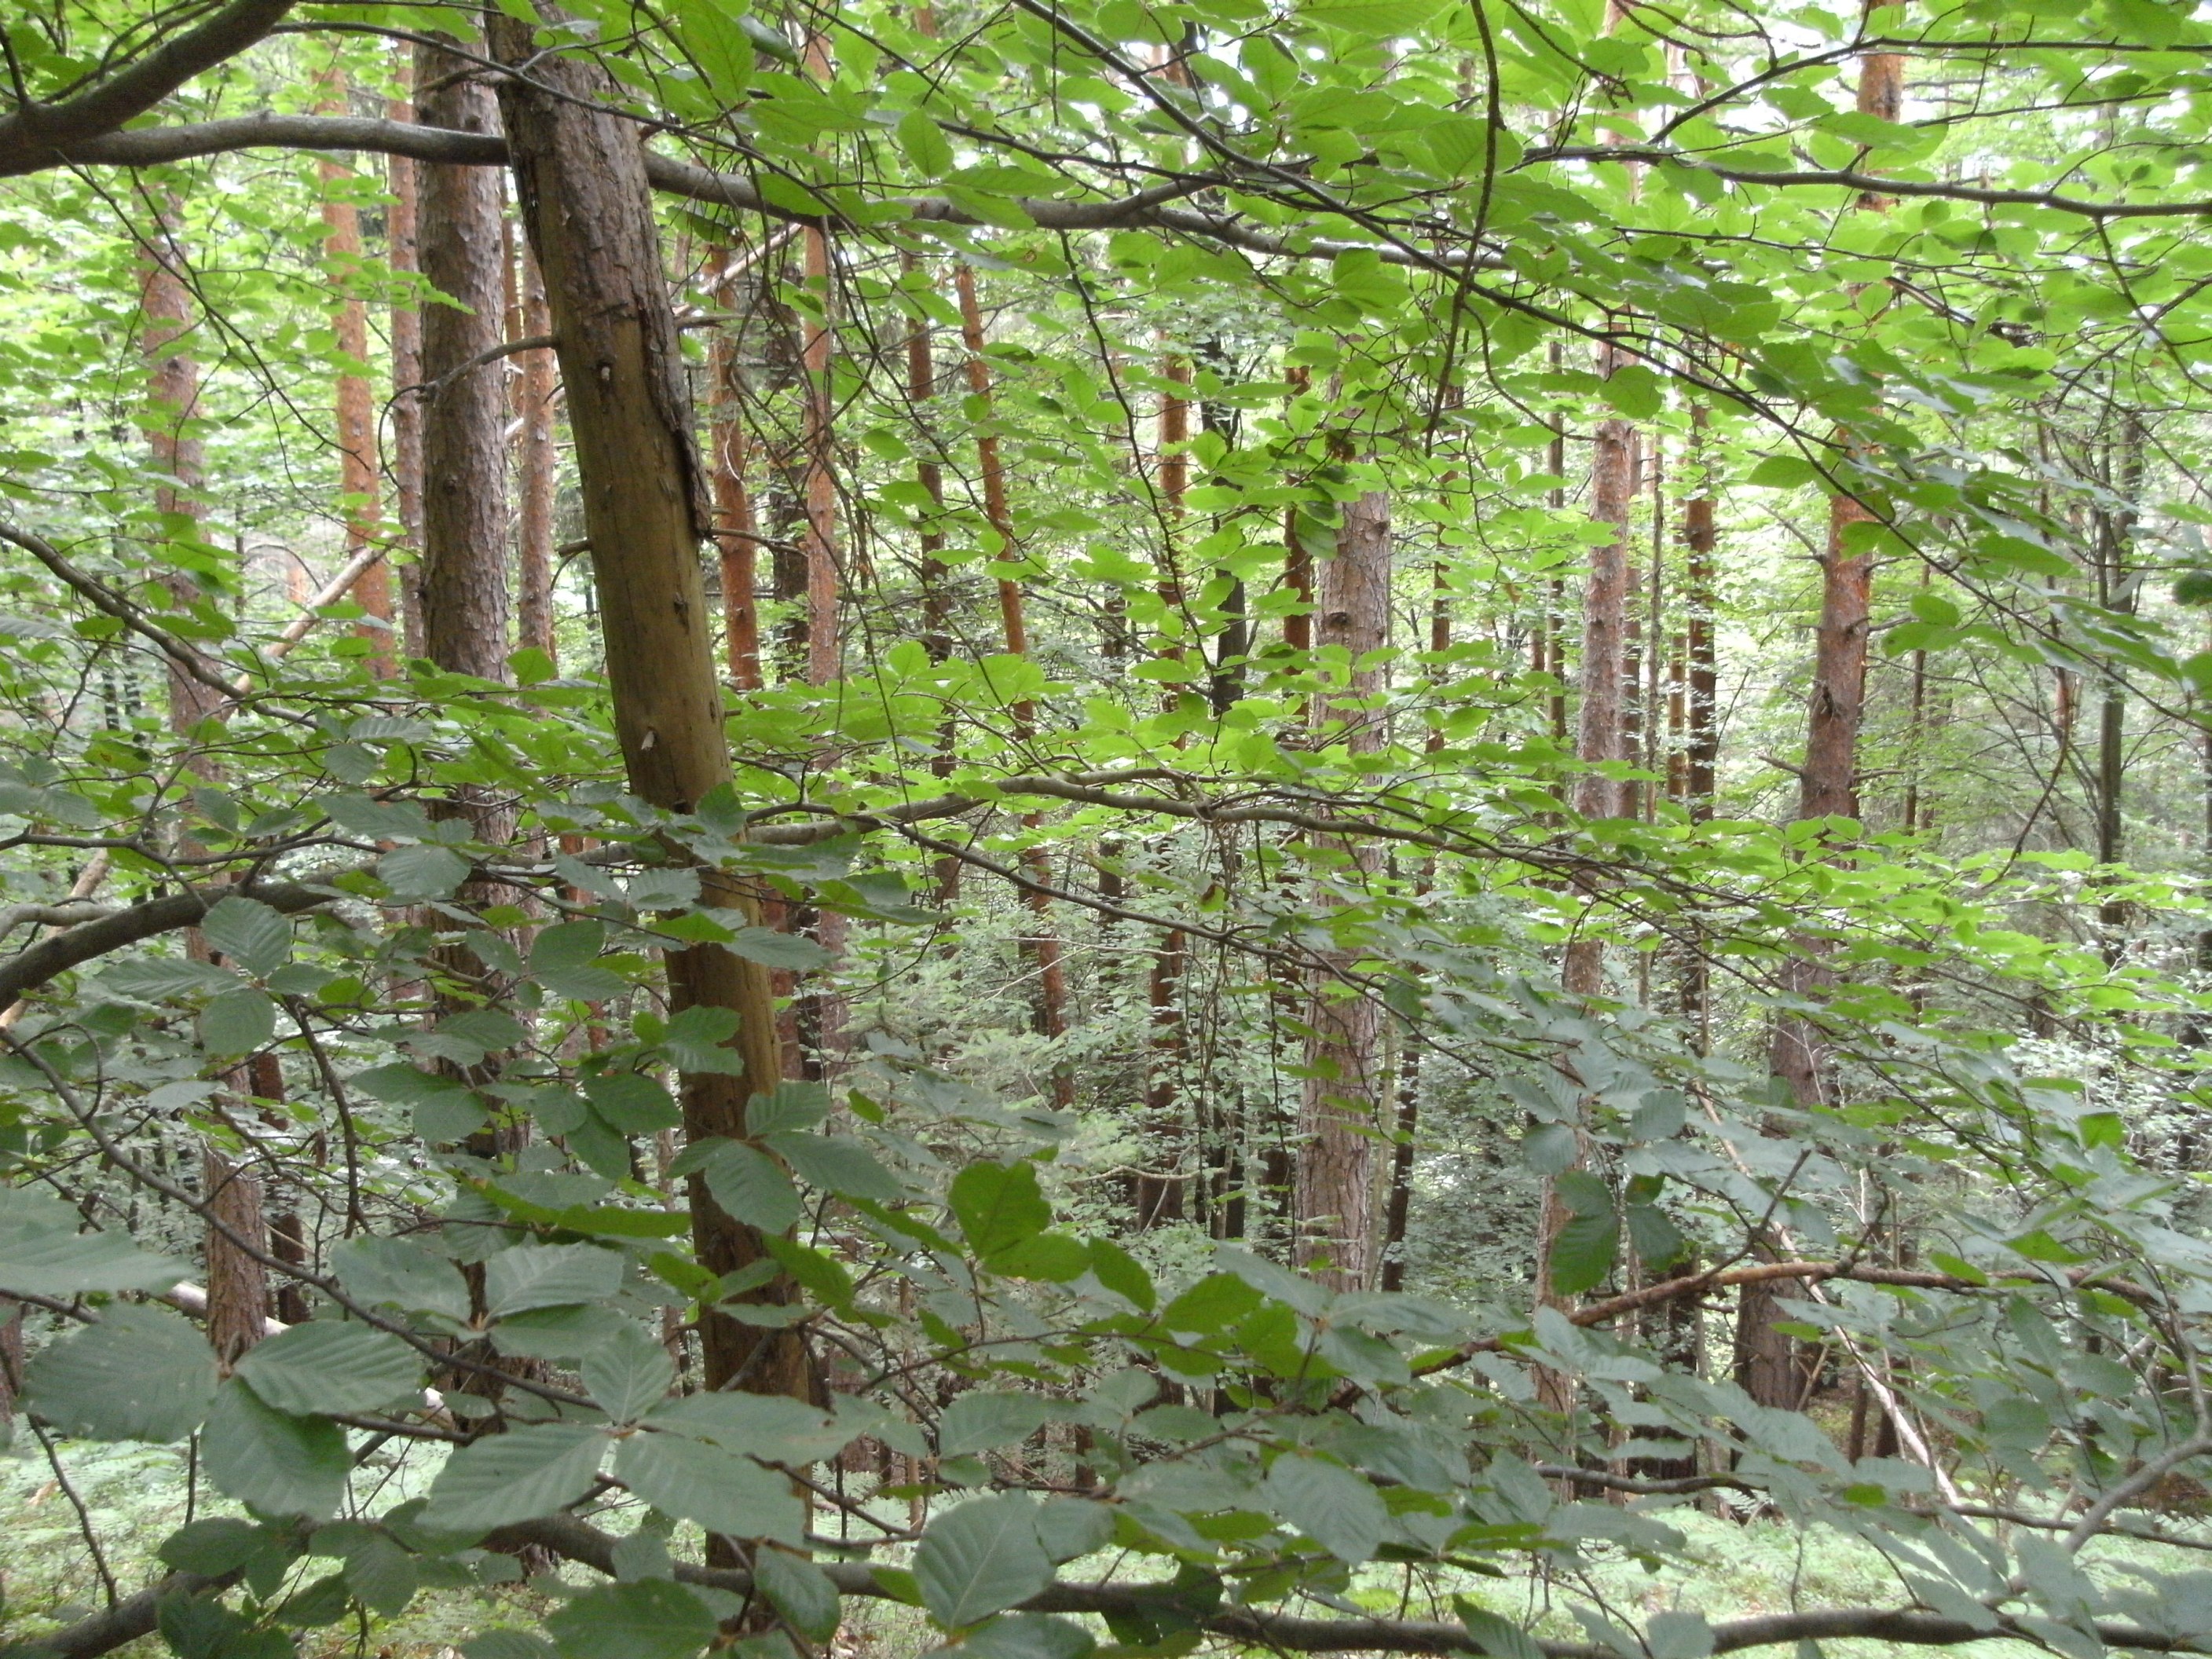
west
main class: Woodland
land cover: Pine dominated coniferous woodland
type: hemiboreal forest and nemoral coniferous forest and mixed broadleaved-coniferous forest
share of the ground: > 75 %
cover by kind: coniferous forest trees 70 %, broadleaved forest trees 10 %, shrubs 10 %, herbaceous plants 10 %
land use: Forestry
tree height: > 5 m
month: July
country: AT
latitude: 46.6216
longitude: 14.8168
